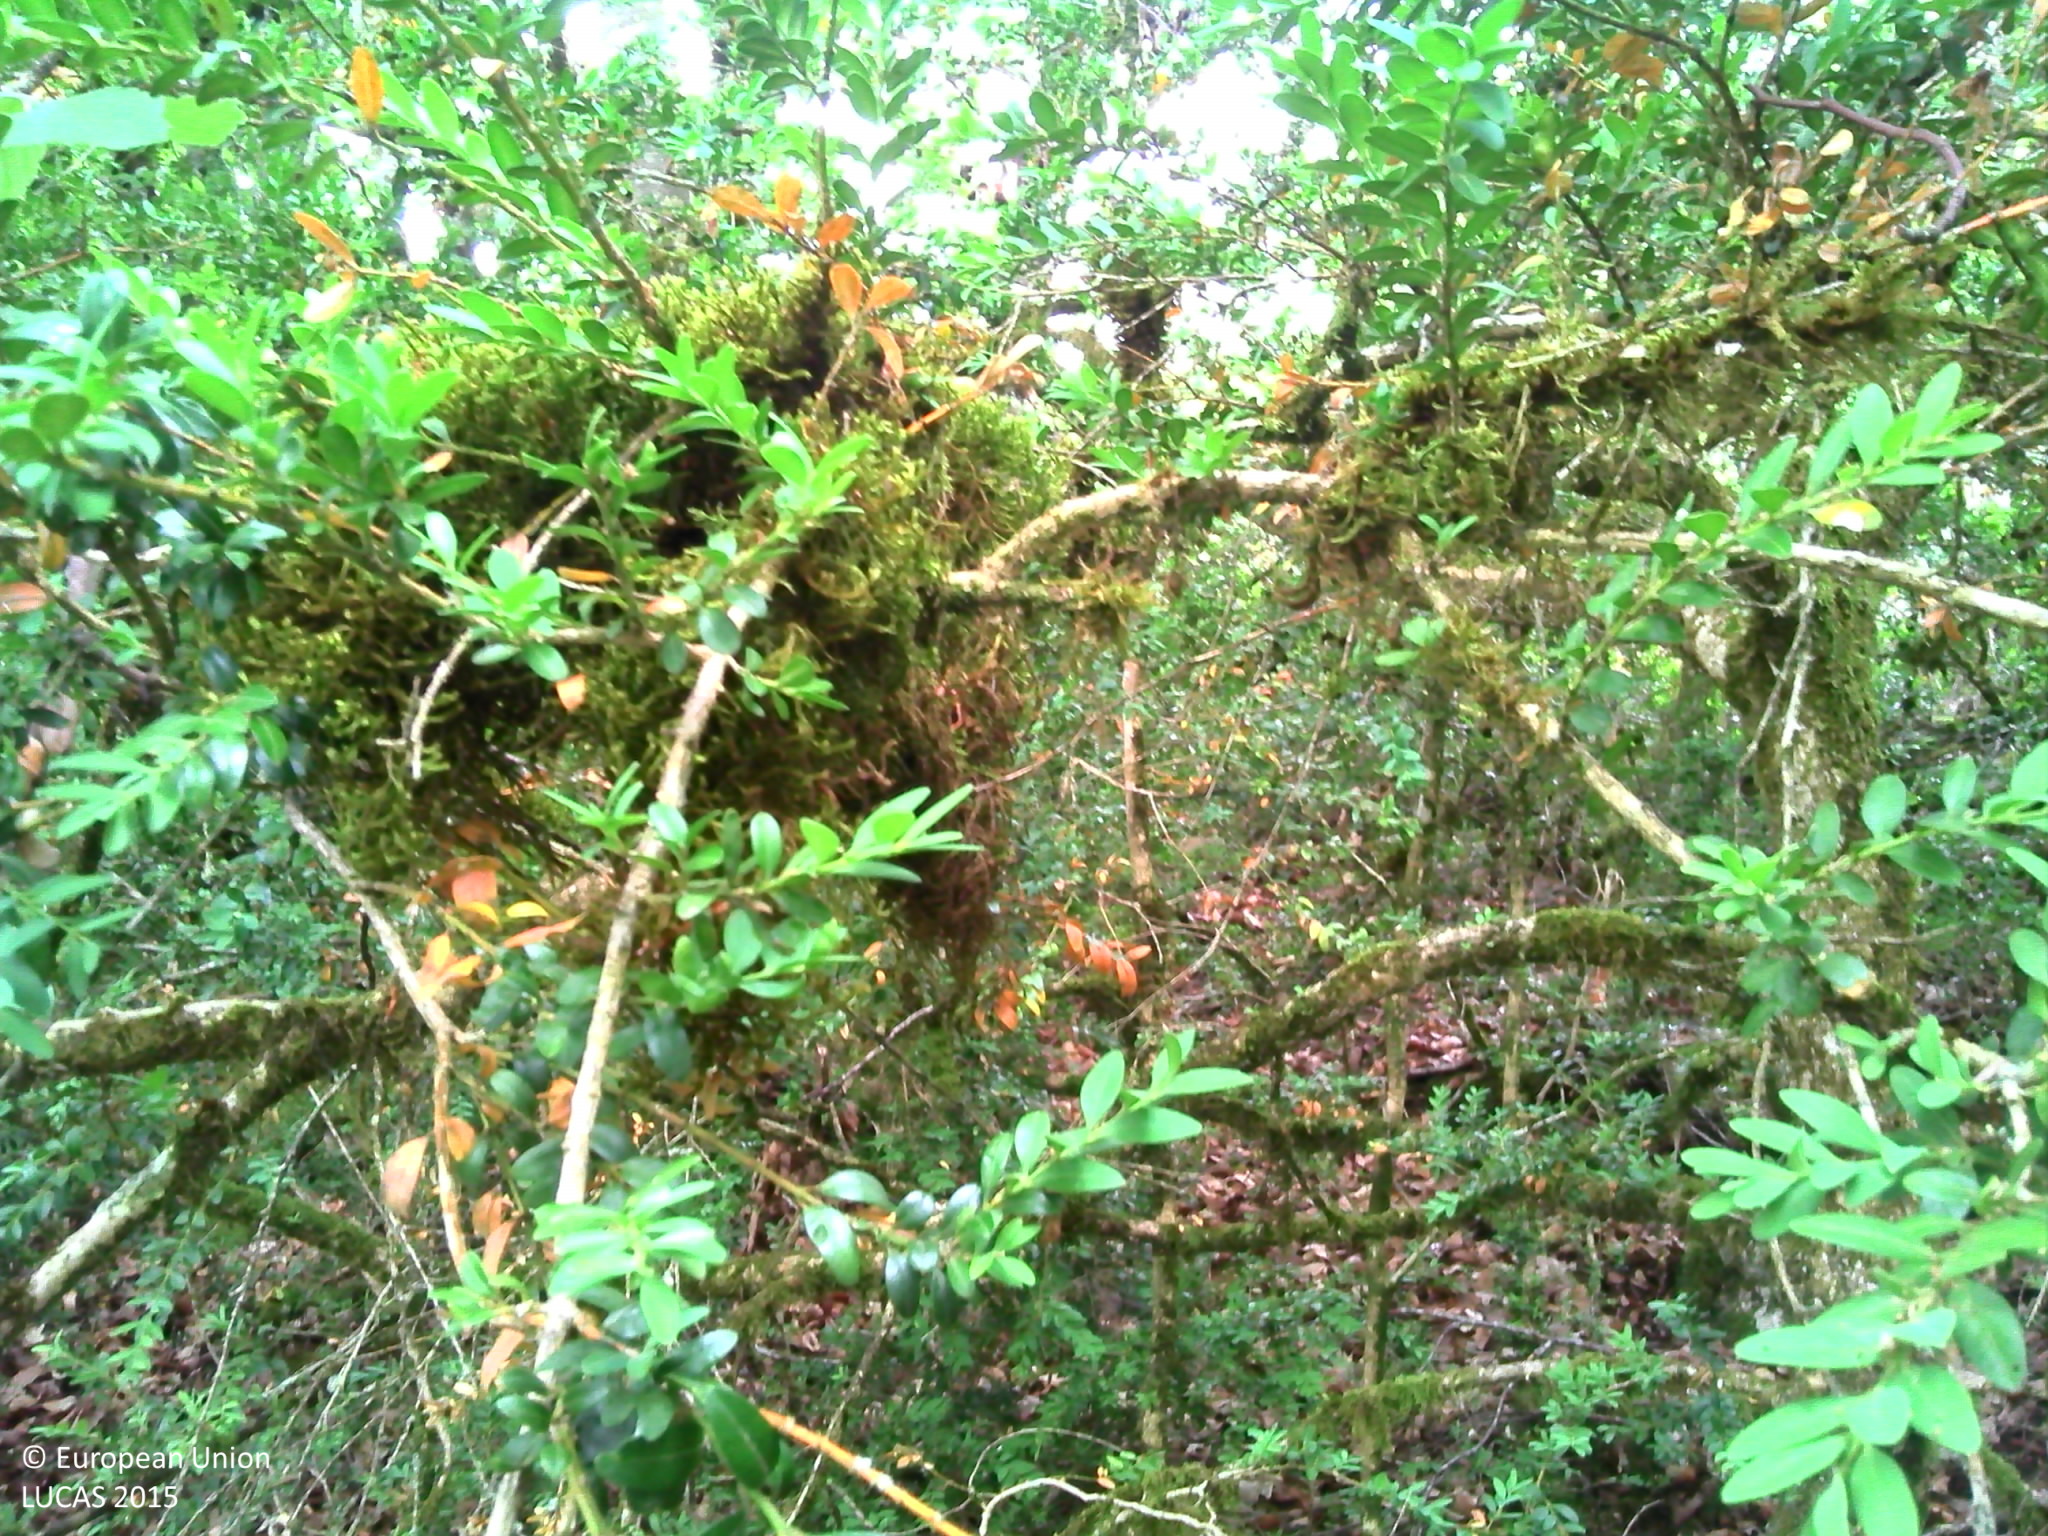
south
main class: Woodland
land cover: Broadleaved woodland
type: acidophilous oak and oak-birch forest
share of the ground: > 75 %
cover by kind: broadleaved forest trees 80 %, shrubs 10 %, herbaceous plants 5 %, lichens and mosses 5 %
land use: Forestry
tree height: > 5 m
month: July
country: FR
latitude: 44.4189
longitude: 2.9583
